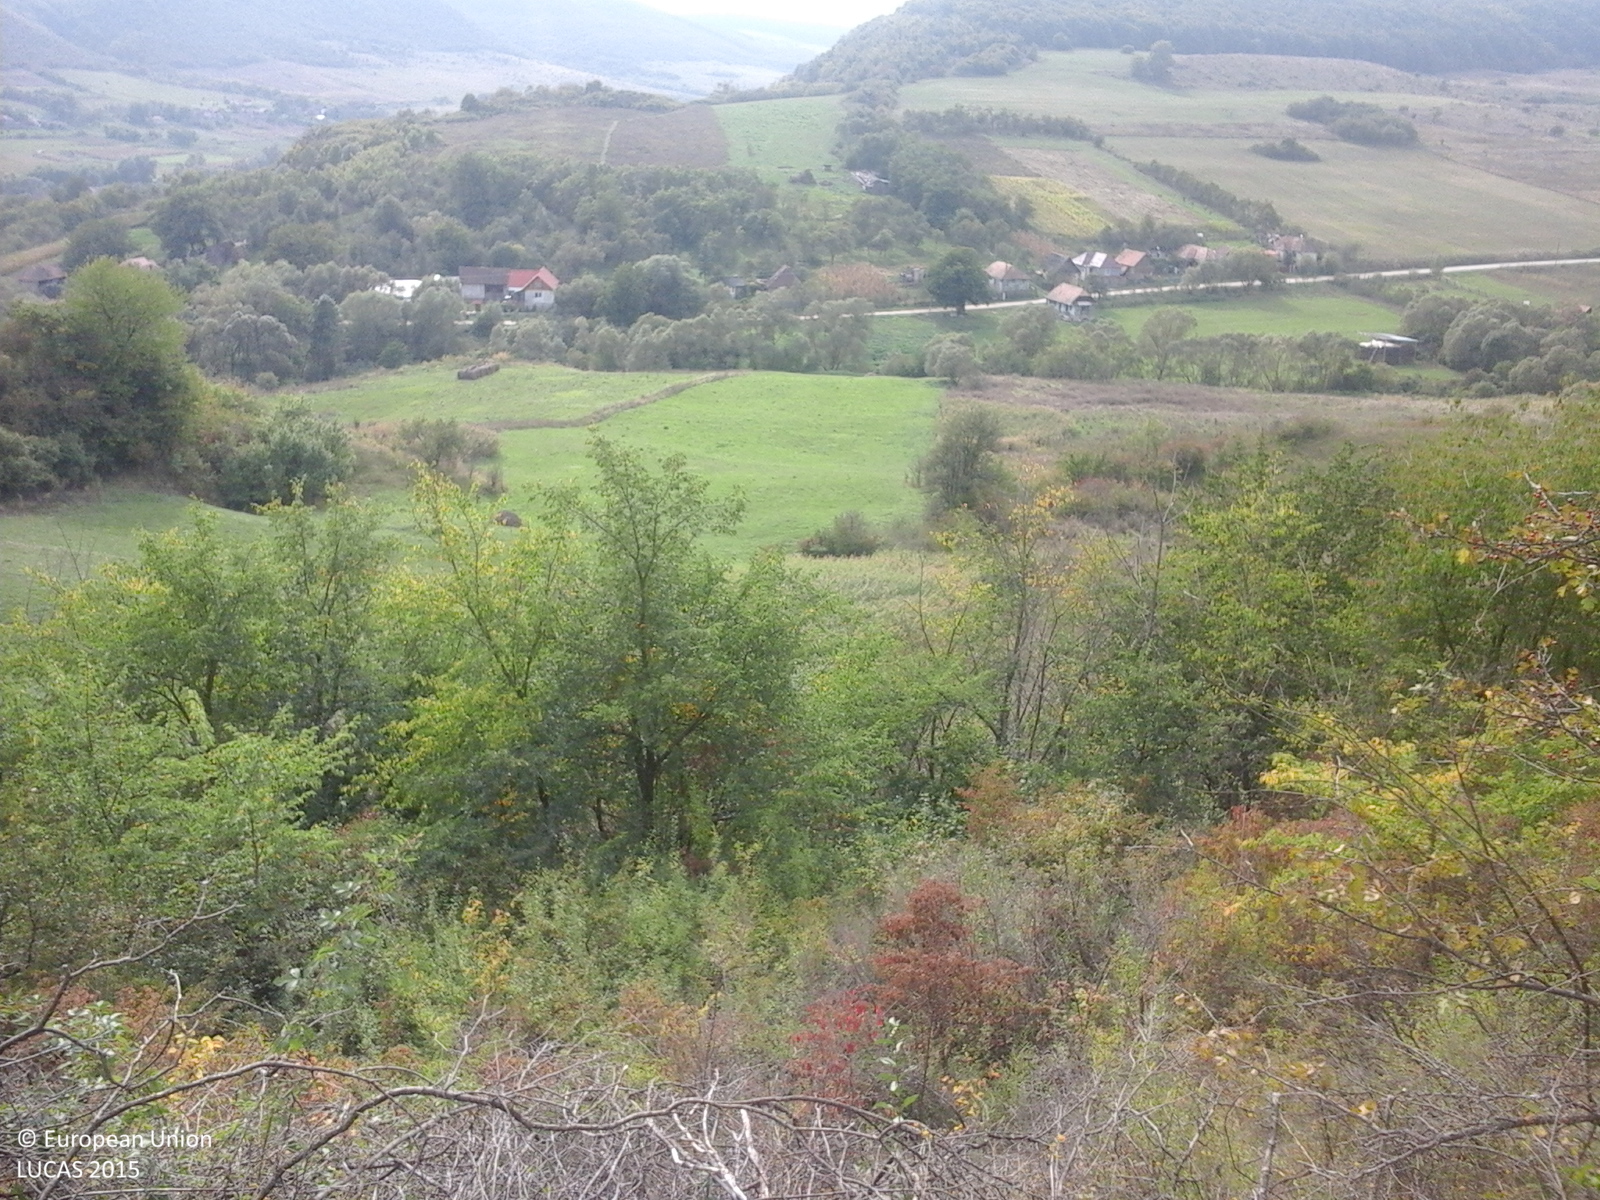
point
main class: Shrubland
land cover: Shrubland with sparse tree cover
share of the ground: > 75 %
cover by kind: herbaceous plants 85 %, shrubs 10 %, broadleaved forest trees 5 %
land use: Fallow land
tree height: < 5 m
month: September
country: RO
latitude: 46.9536
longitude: 23.6198
